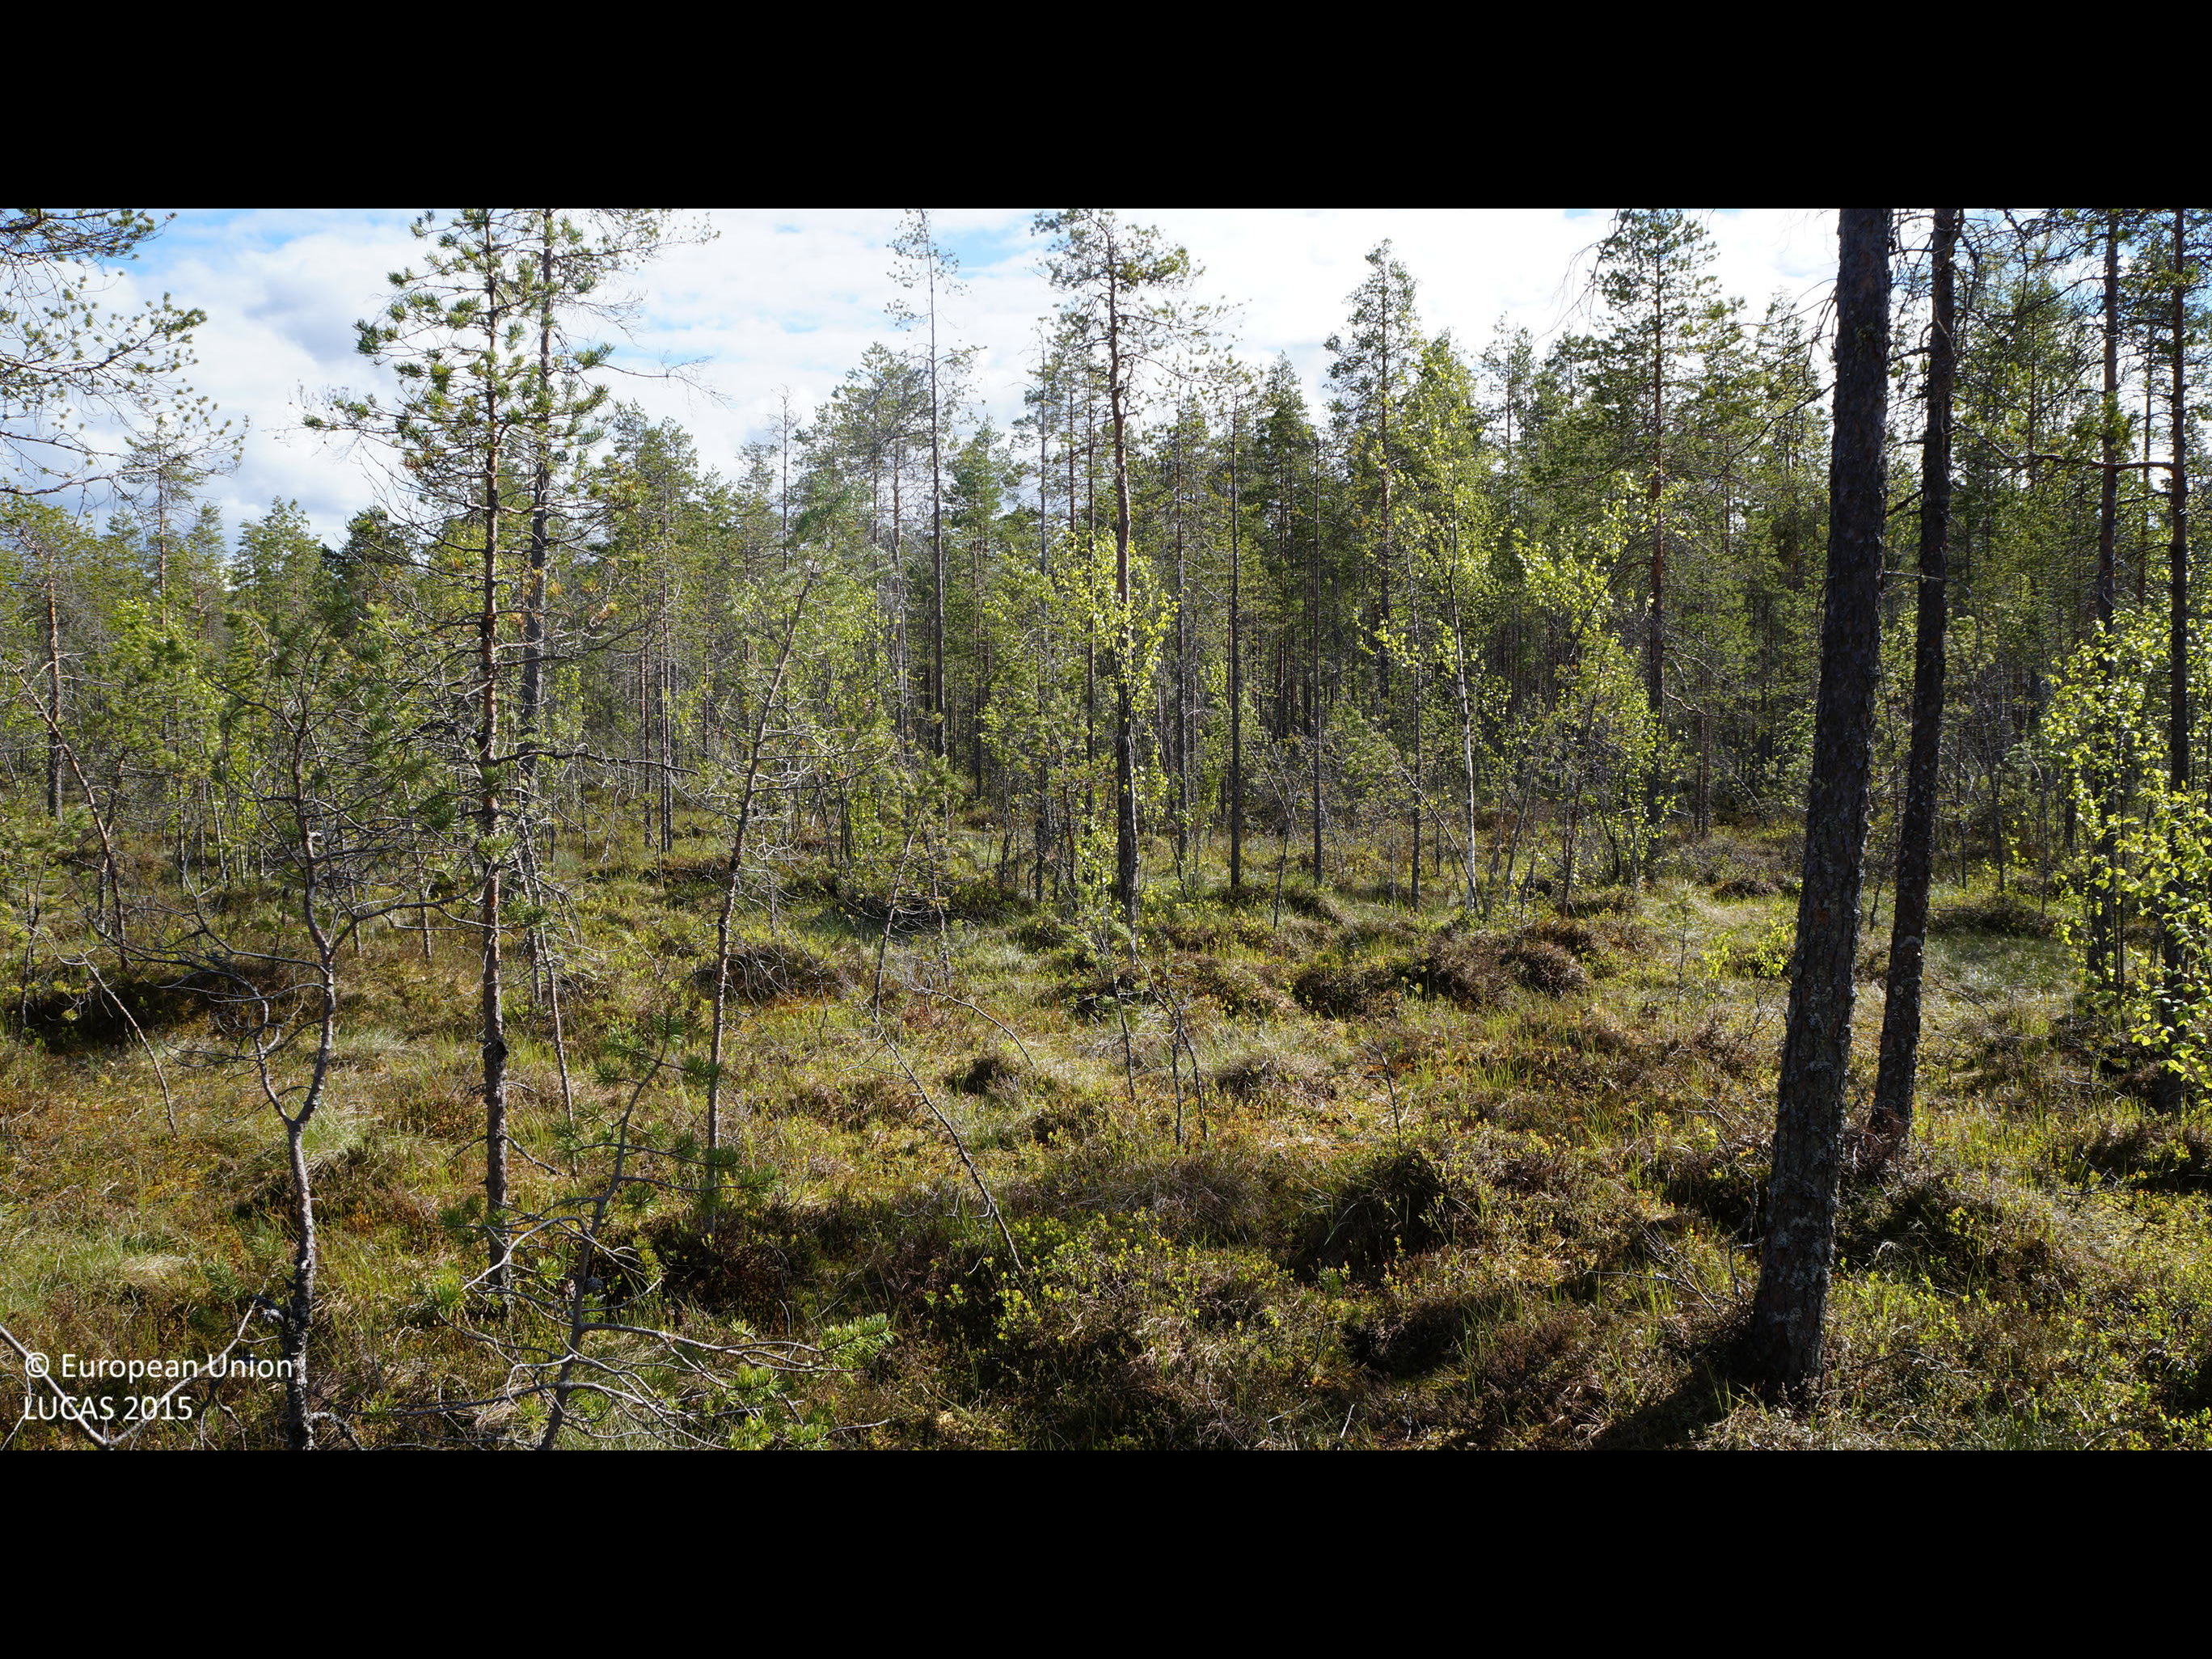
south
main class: Woodland
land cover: Pine dominated coniferous woodland
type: boreal forest
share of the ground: 50 - 75 %
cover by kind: coniferous forest trees 70 %, lichens and mosses 20 %, herbaceous plants 10 %
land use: Forestry
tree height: > 5 m
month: June
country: FI
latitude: 63.8015
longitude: 24.0979
